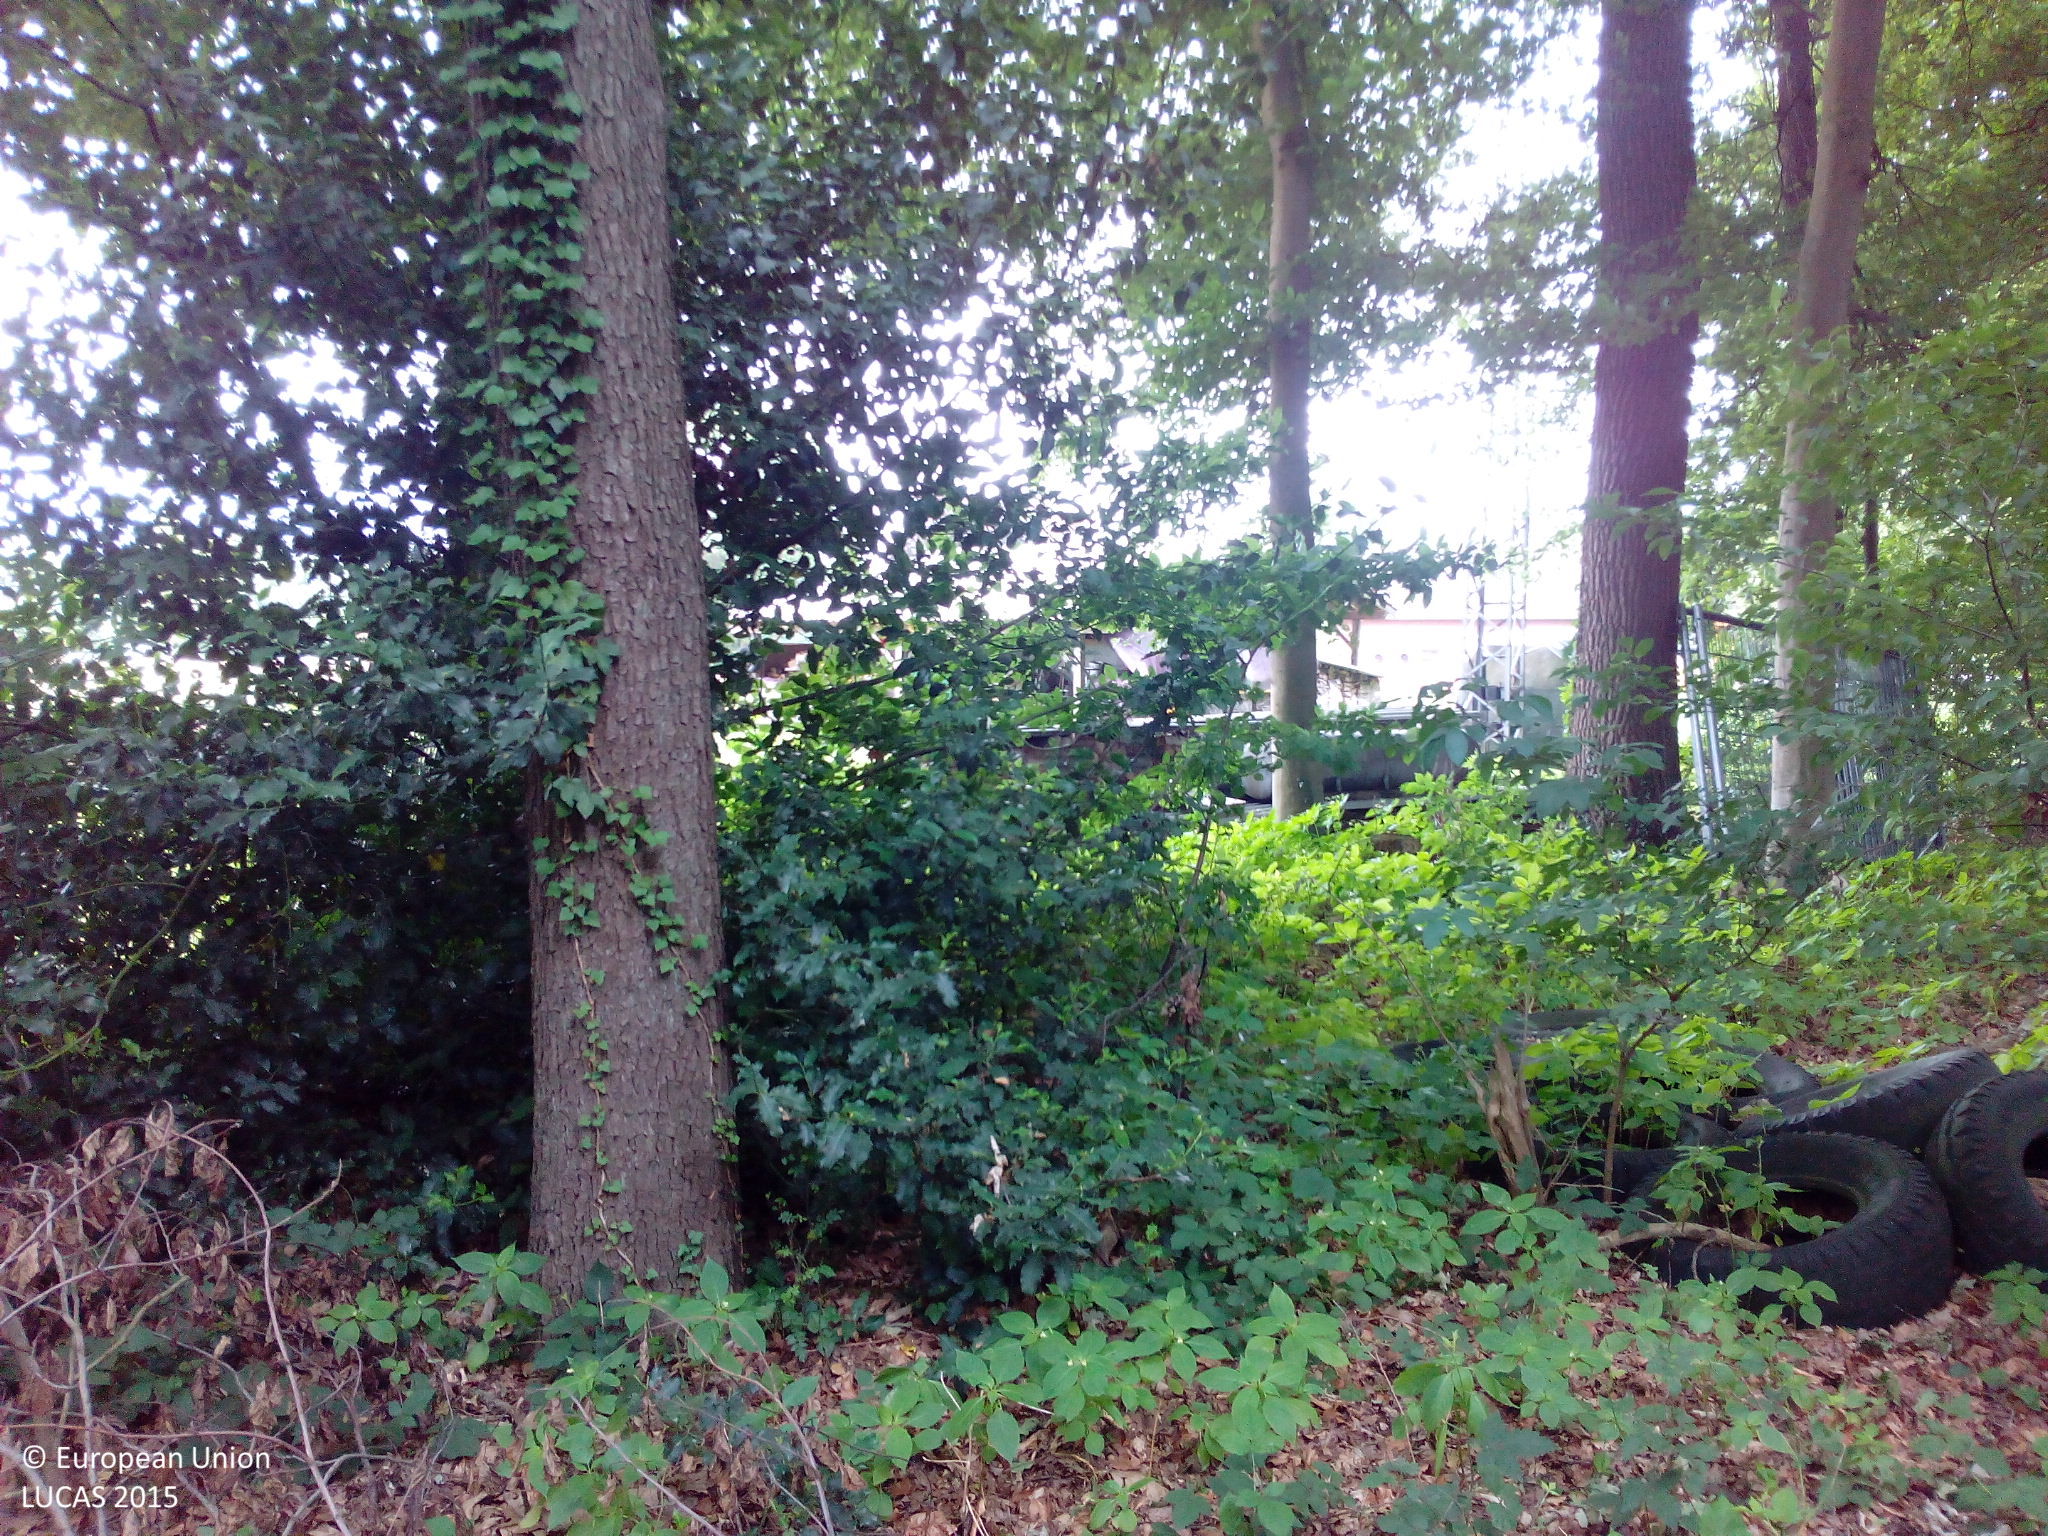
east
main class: Woodland
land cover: Broadleaved woodland
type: mesophytic deciduous forest
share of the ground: > 75 %
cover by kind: broadleaved forest trees 100 %
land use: Agriculture (excluding fallow land and kitchen gardens)
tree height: > 5 m
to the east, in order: Broadleaved woodland; Artificial constructions in urban areas; Grass margins; Broadleaved woodland; Ditches and canals; Broadleaved woodland; Maize
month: July
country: DE
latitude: 51.8295
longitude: 8.5638
